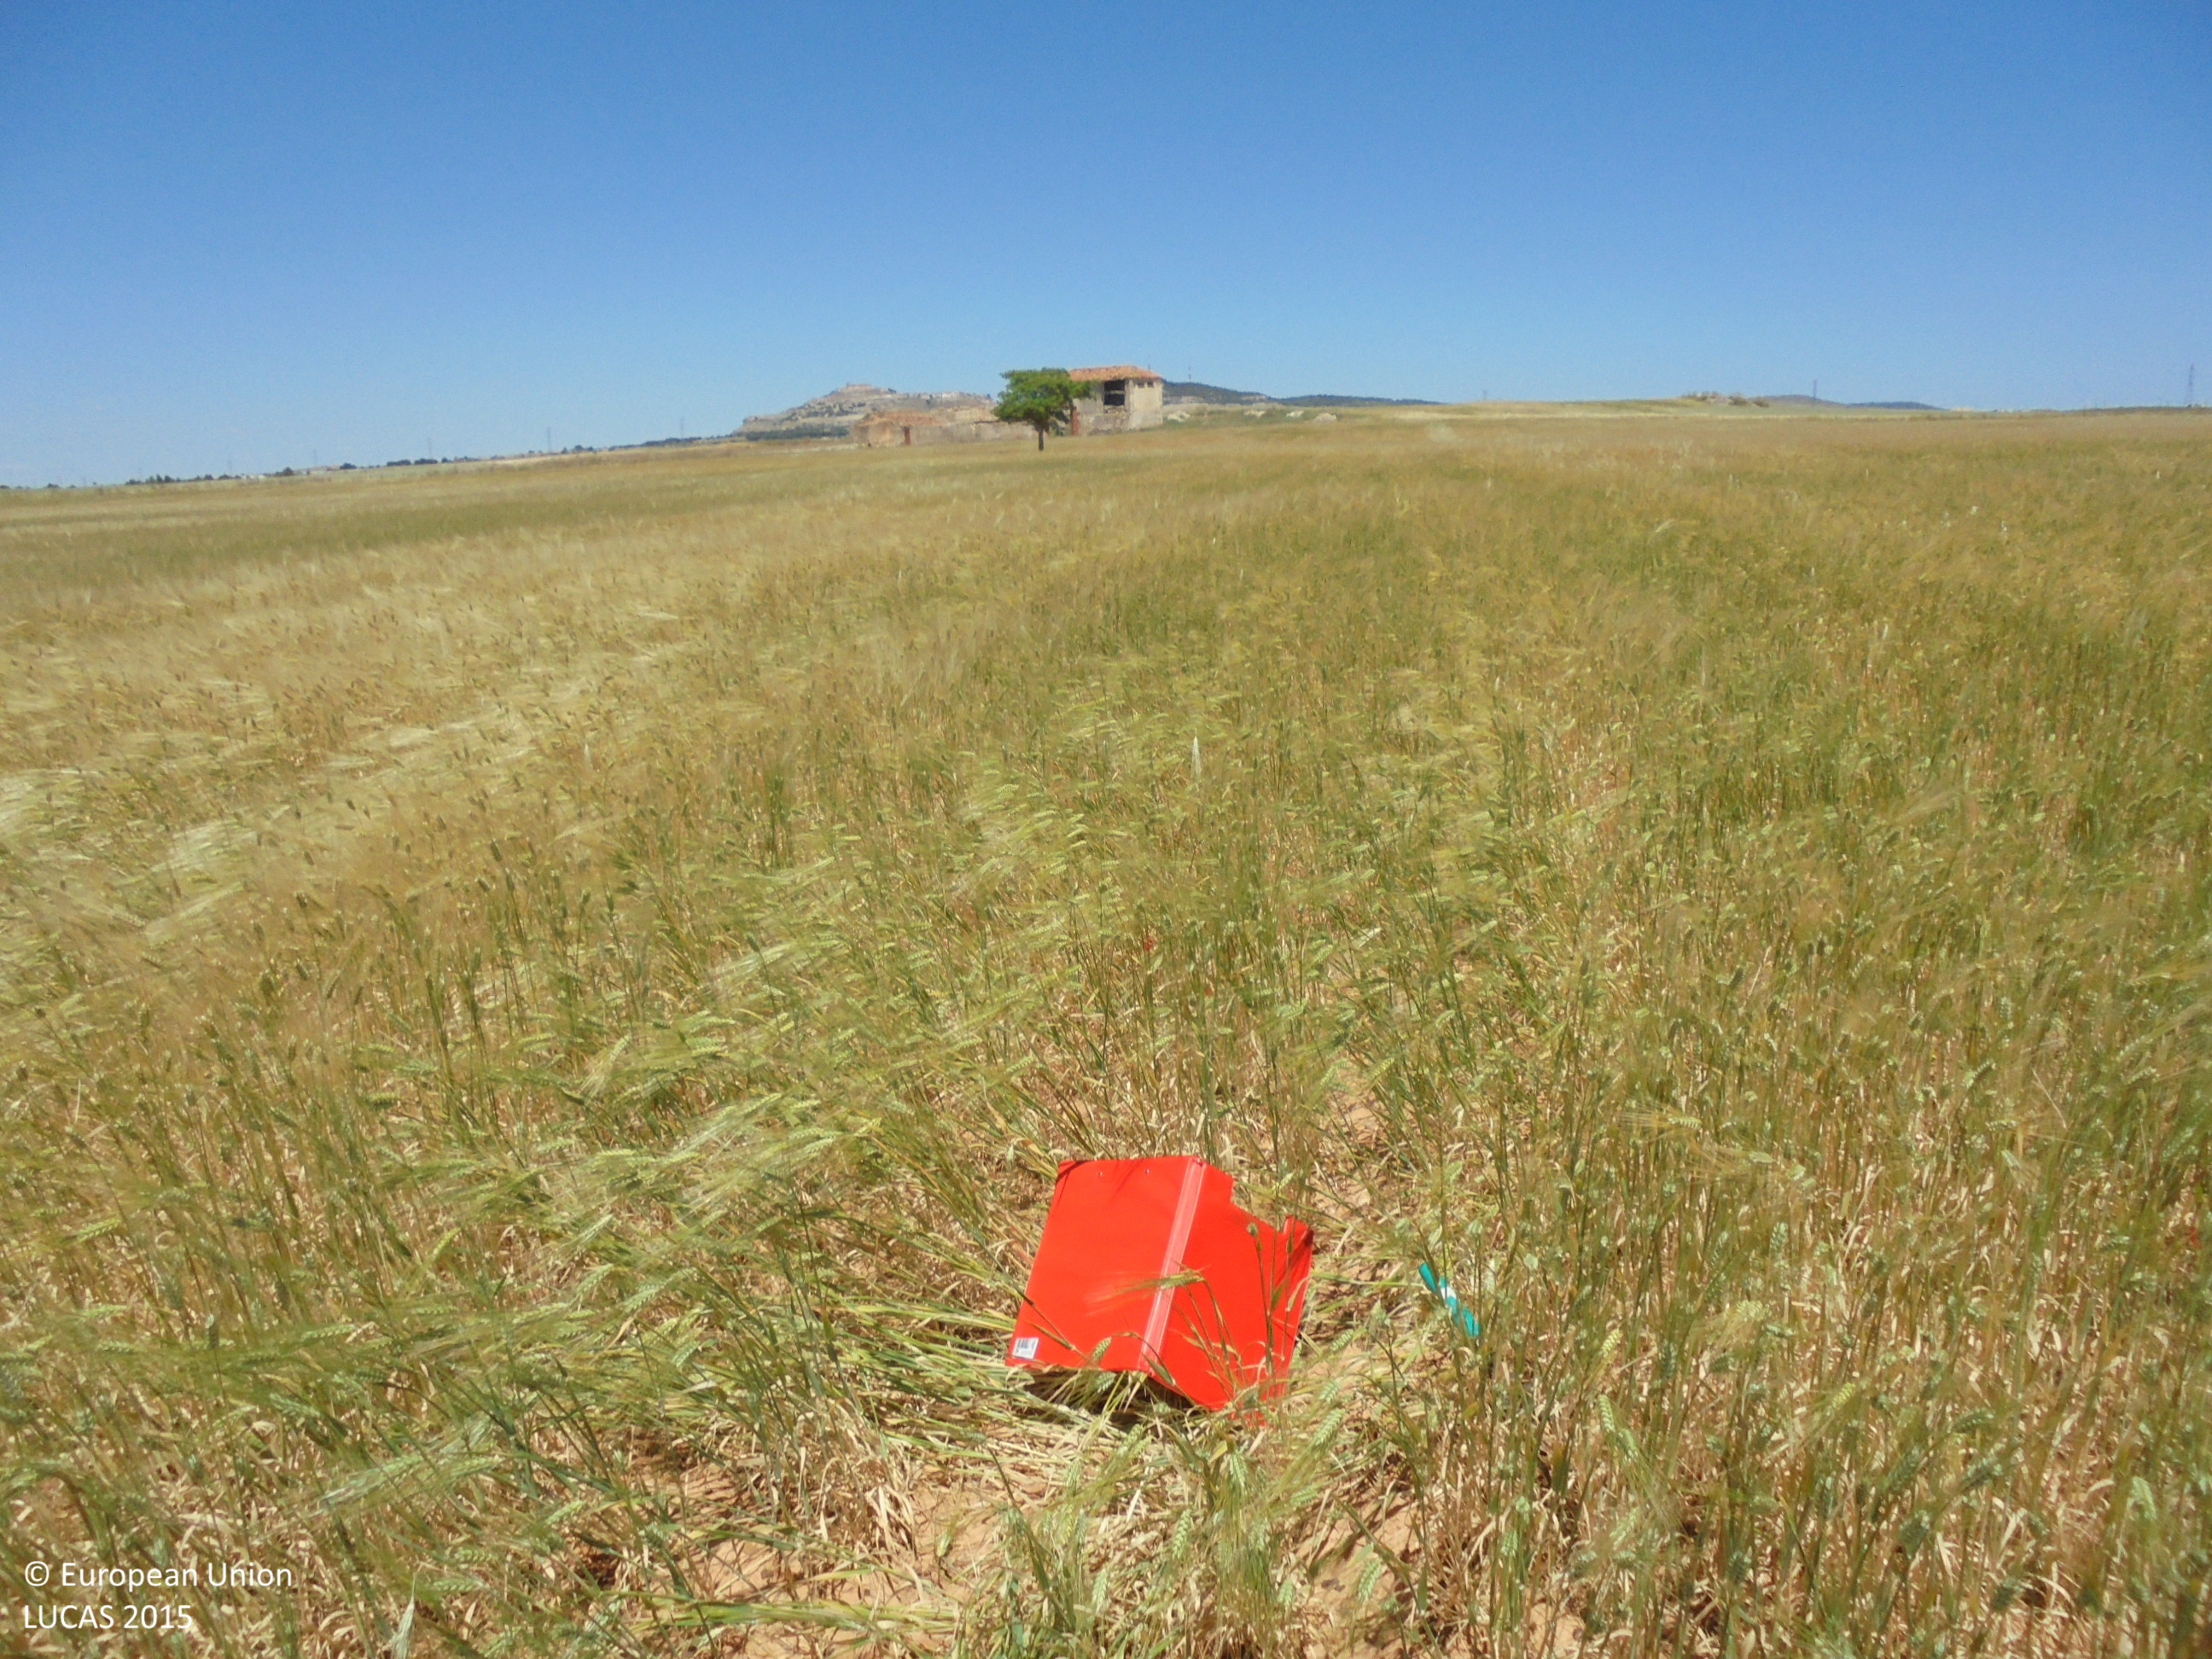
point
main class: Cropland
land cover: Barley
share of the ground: > 75 %
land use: Agriculture (excluding fallow land and kitchen gardens)
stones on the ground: < 10 %
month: May
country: ES
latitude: 38.8832
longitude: -1.7451
